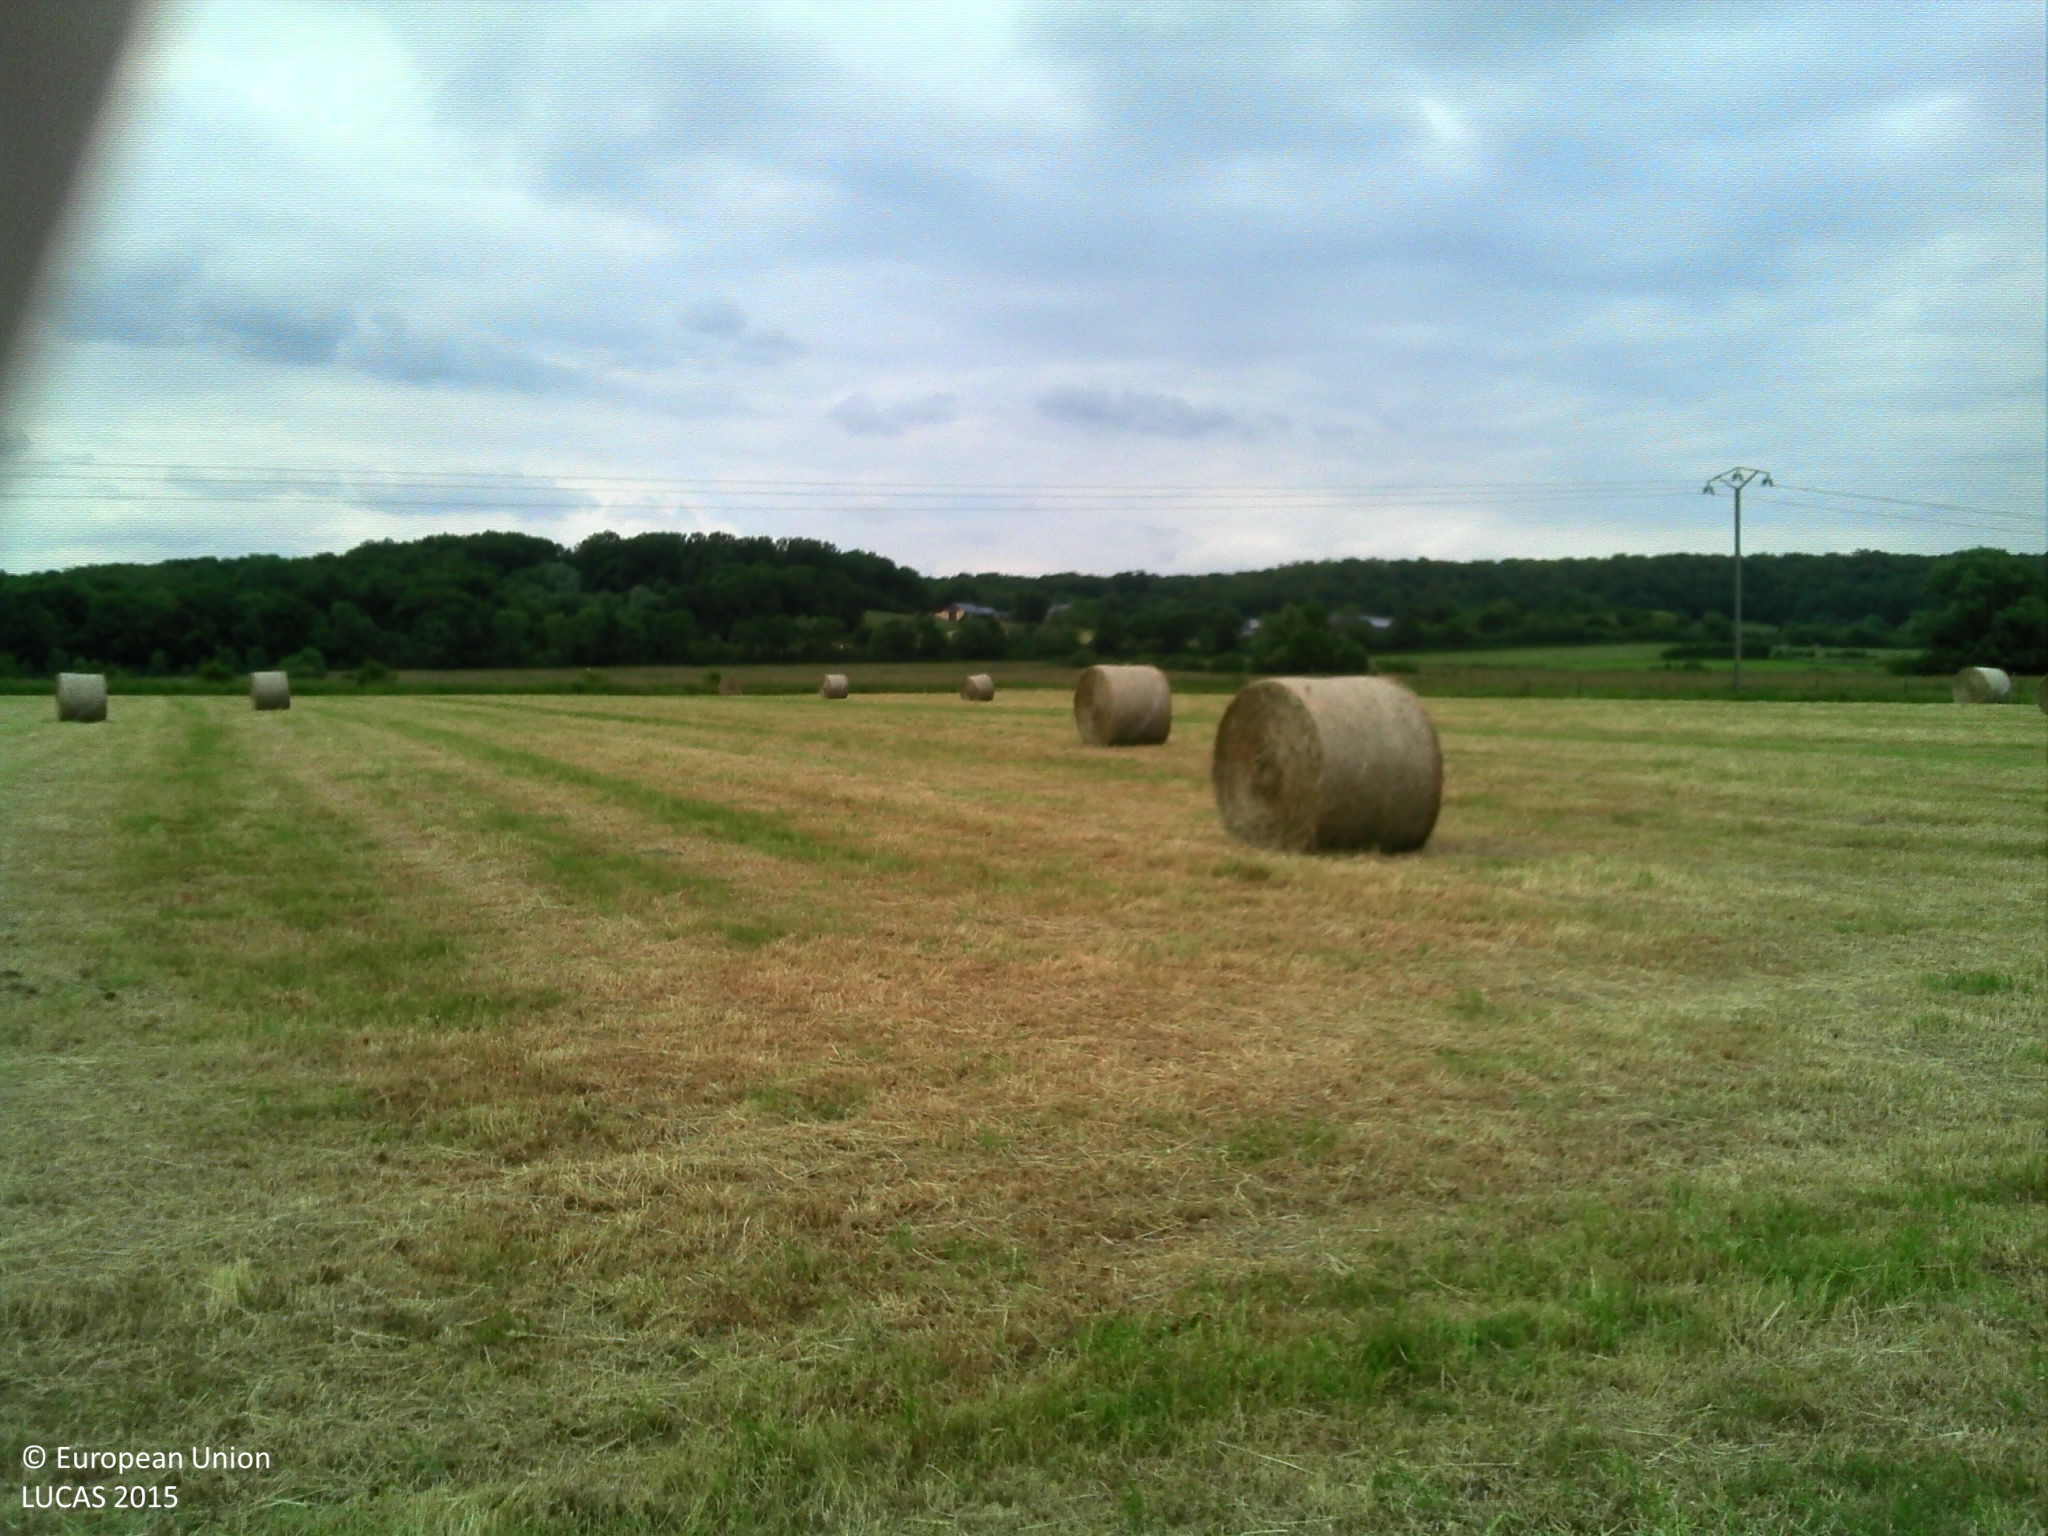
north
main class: Cropland
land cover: Temporary grasslands
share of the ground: > 75 %
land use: Agriculture (excluding fallow land and kitchen gardens)
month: June
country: LU
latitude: 49.5701
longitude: 5.8923
